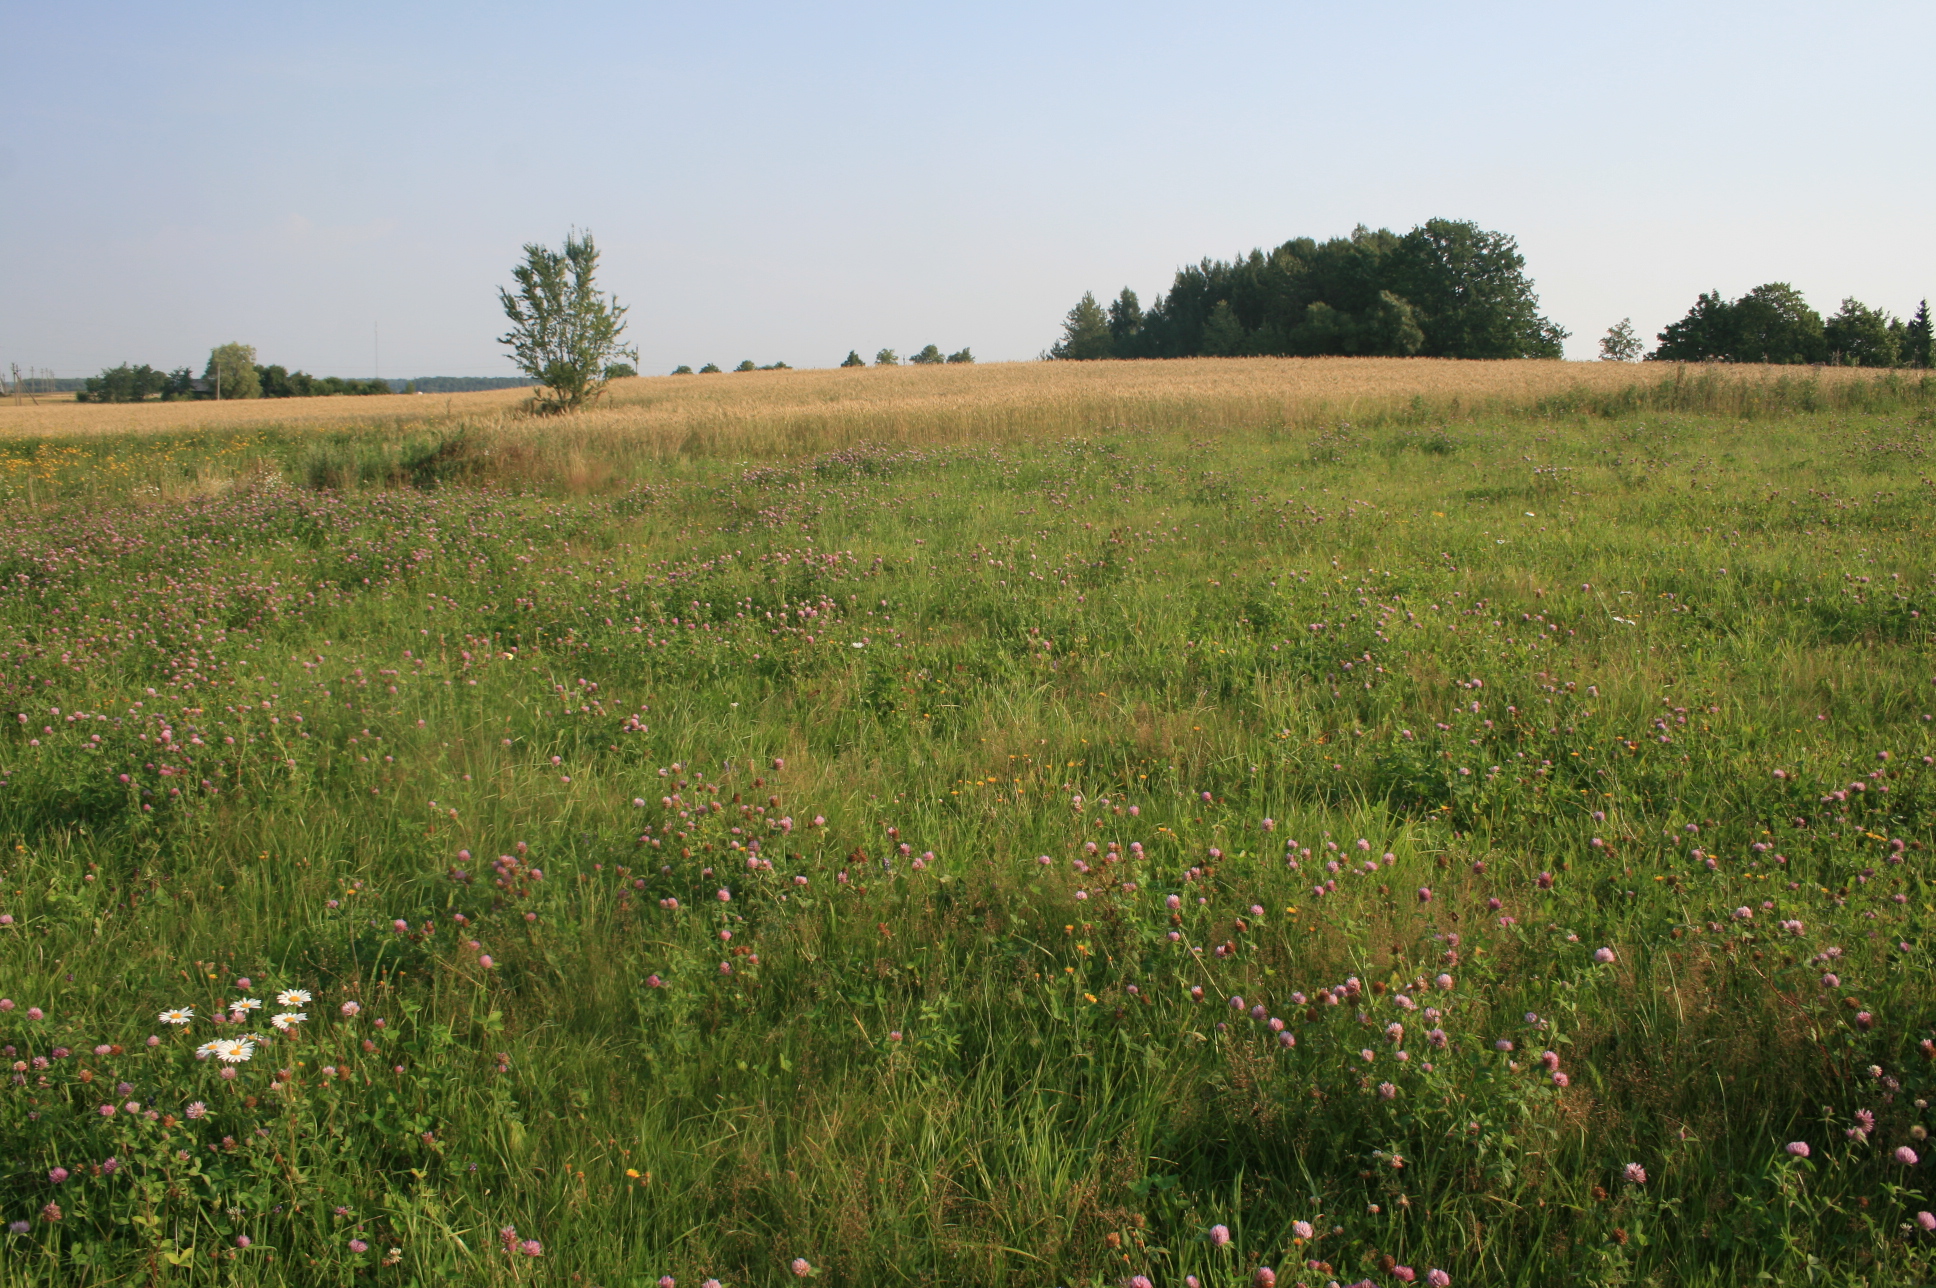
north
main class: Cropland
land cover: Other leguminous and mixtures for fodder
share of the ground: > 75 %
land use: Agriculture (excluding fallow land and kitchen gardens)
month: August
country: LT
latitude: 55.6063
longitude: 21.5867
